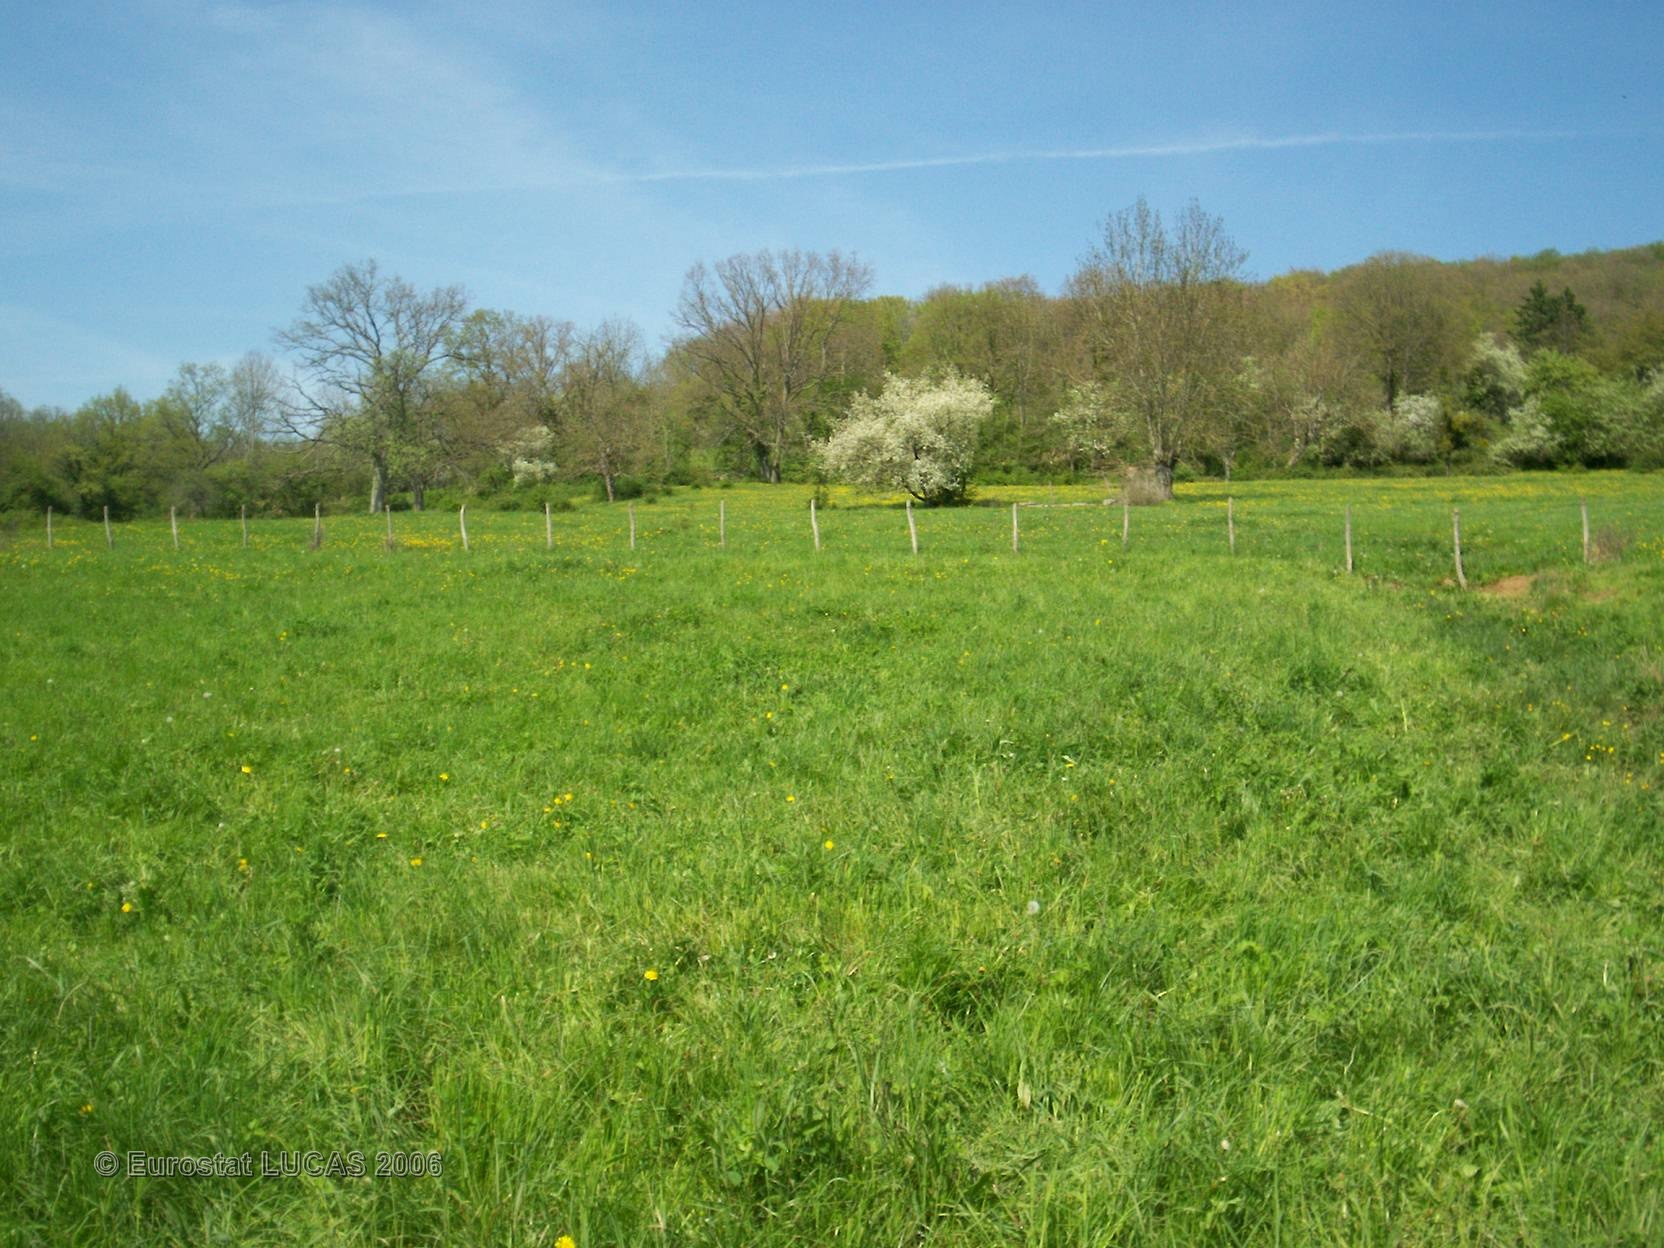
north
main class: Grassland
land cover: Grassland without tree/shrub cover
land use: Agriculture (excluding fallow land and kitchen gardens)
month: May
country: FR
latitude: 47.5331
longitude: 4.6195
